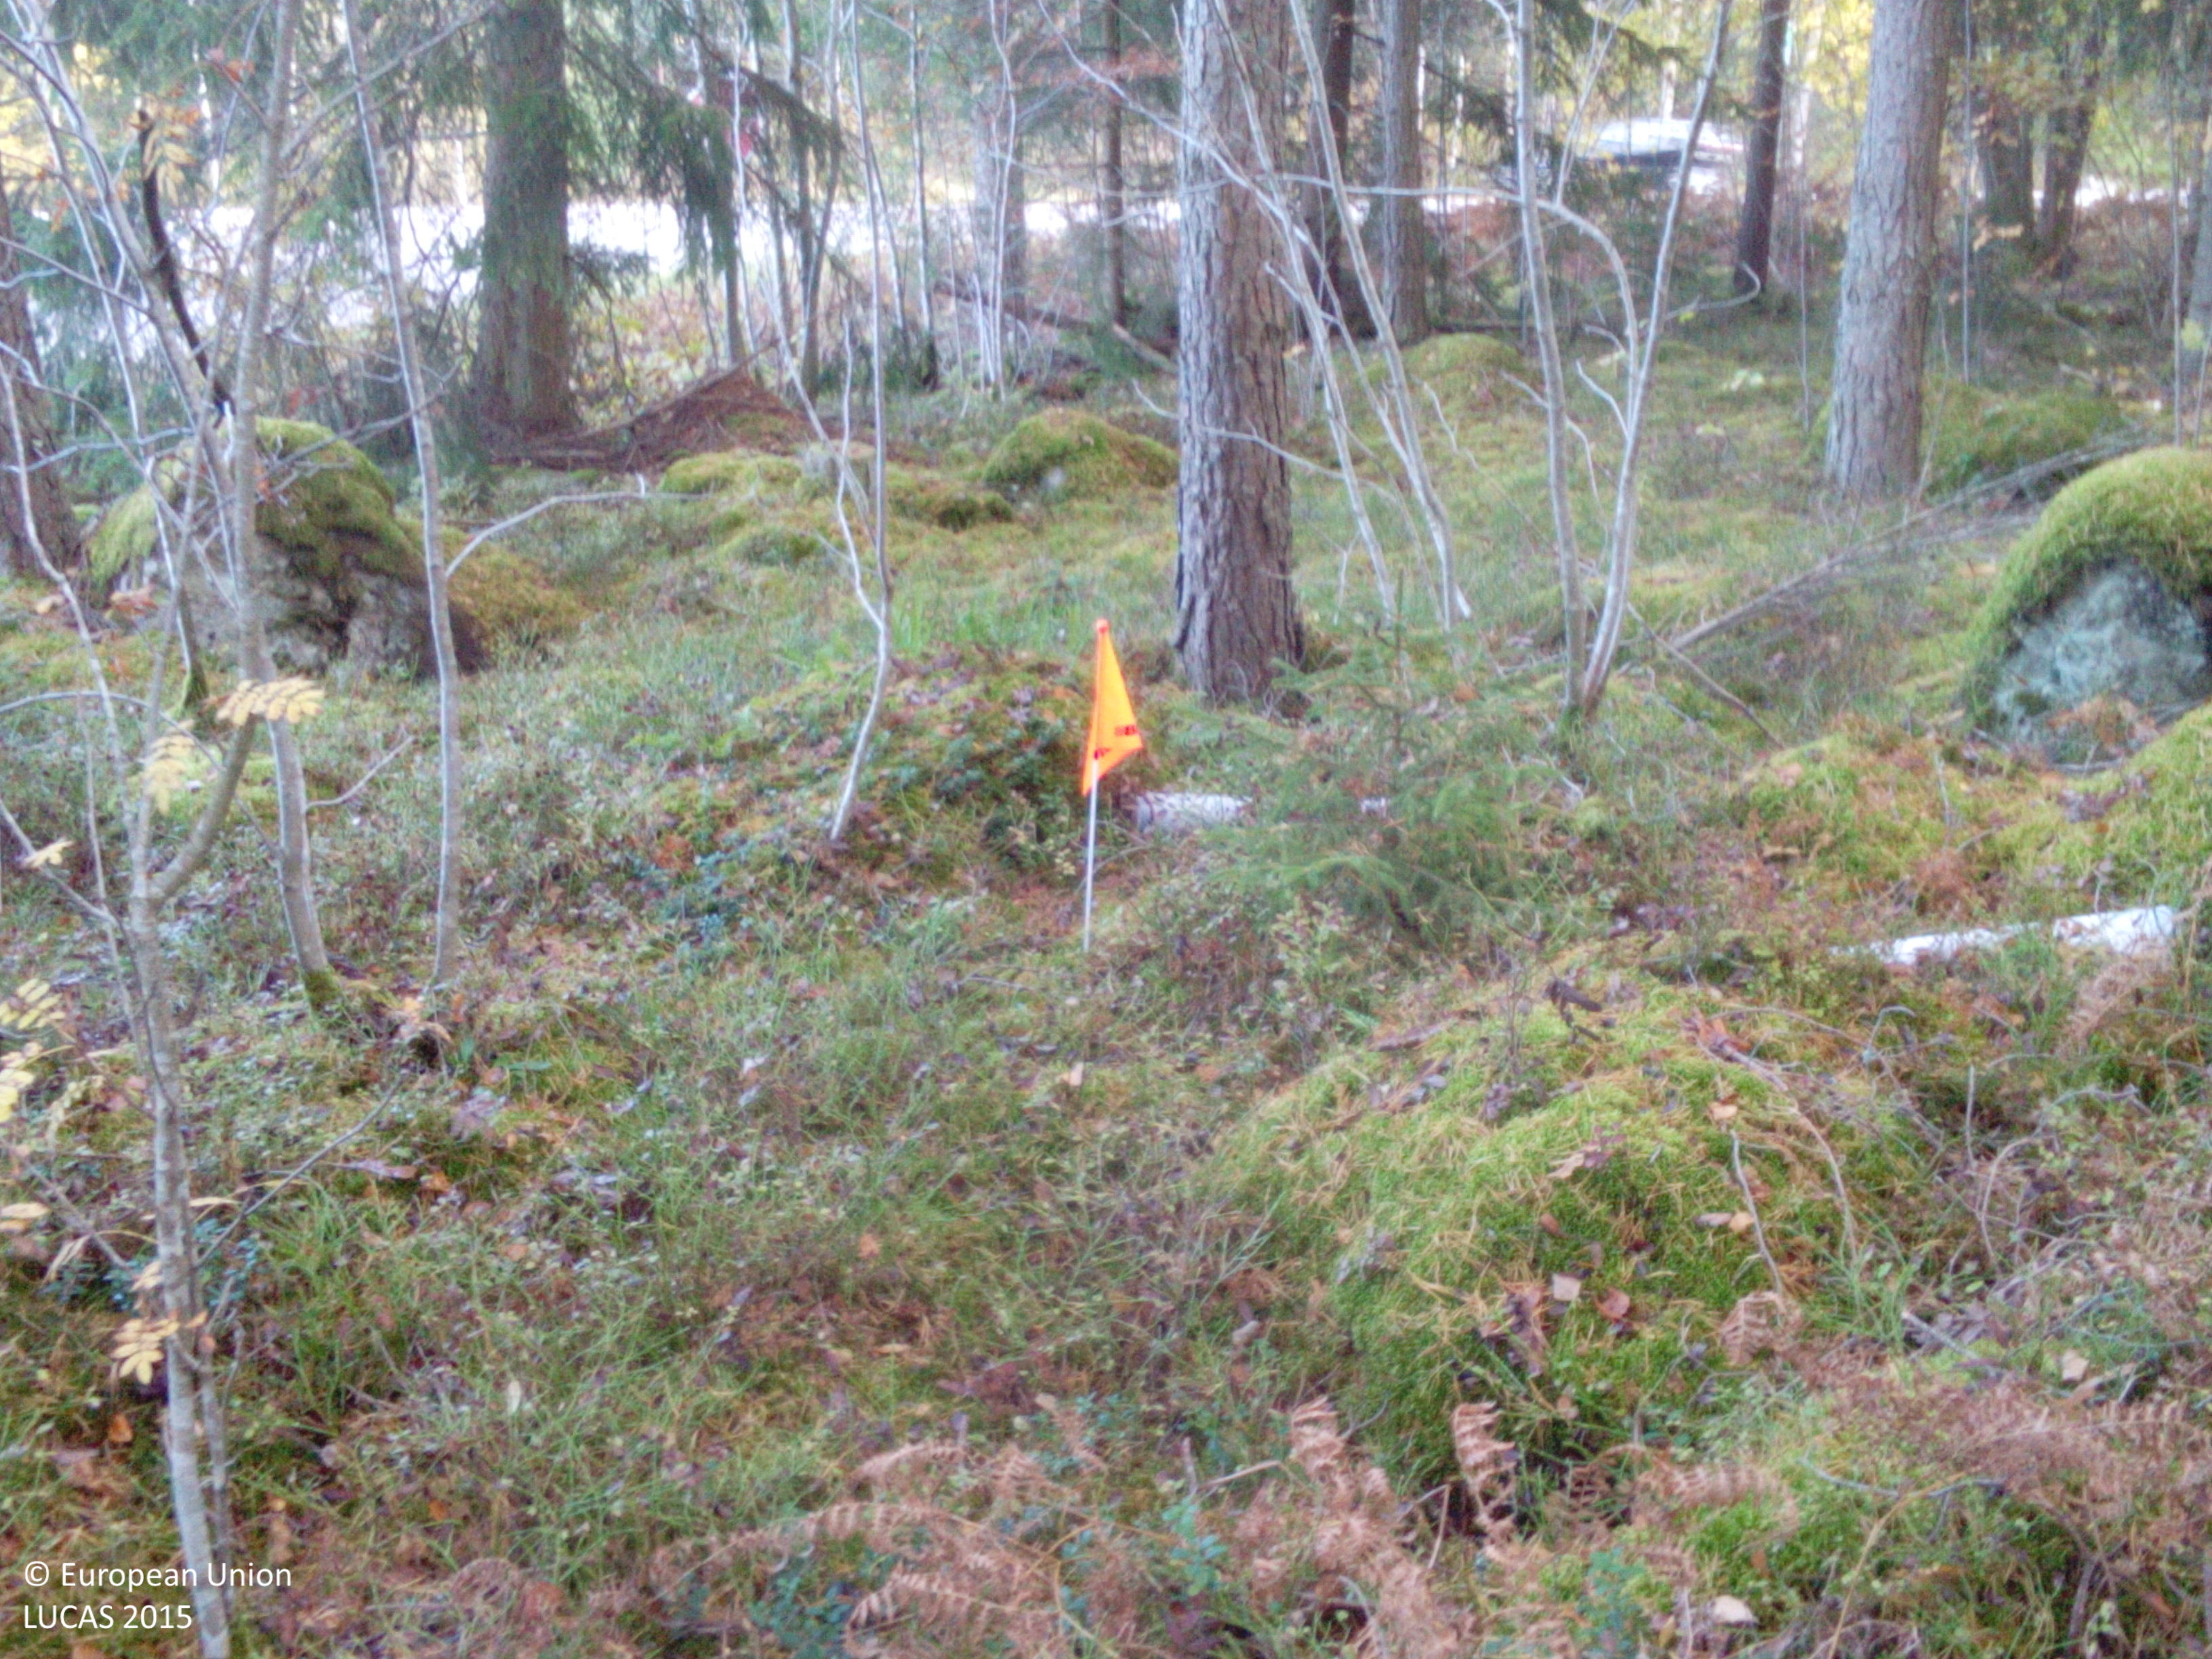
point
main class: Woodland
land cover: Other coniferous woodland
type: boreal forest
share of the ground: > 75 %
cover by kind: coniferous forest trees 85 %, lichens and mosses 10 %, herbaceous plants 5 %
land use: Forestry
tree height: > 5 m
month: October
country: SE
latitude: 59.0325
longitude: 16.2139
